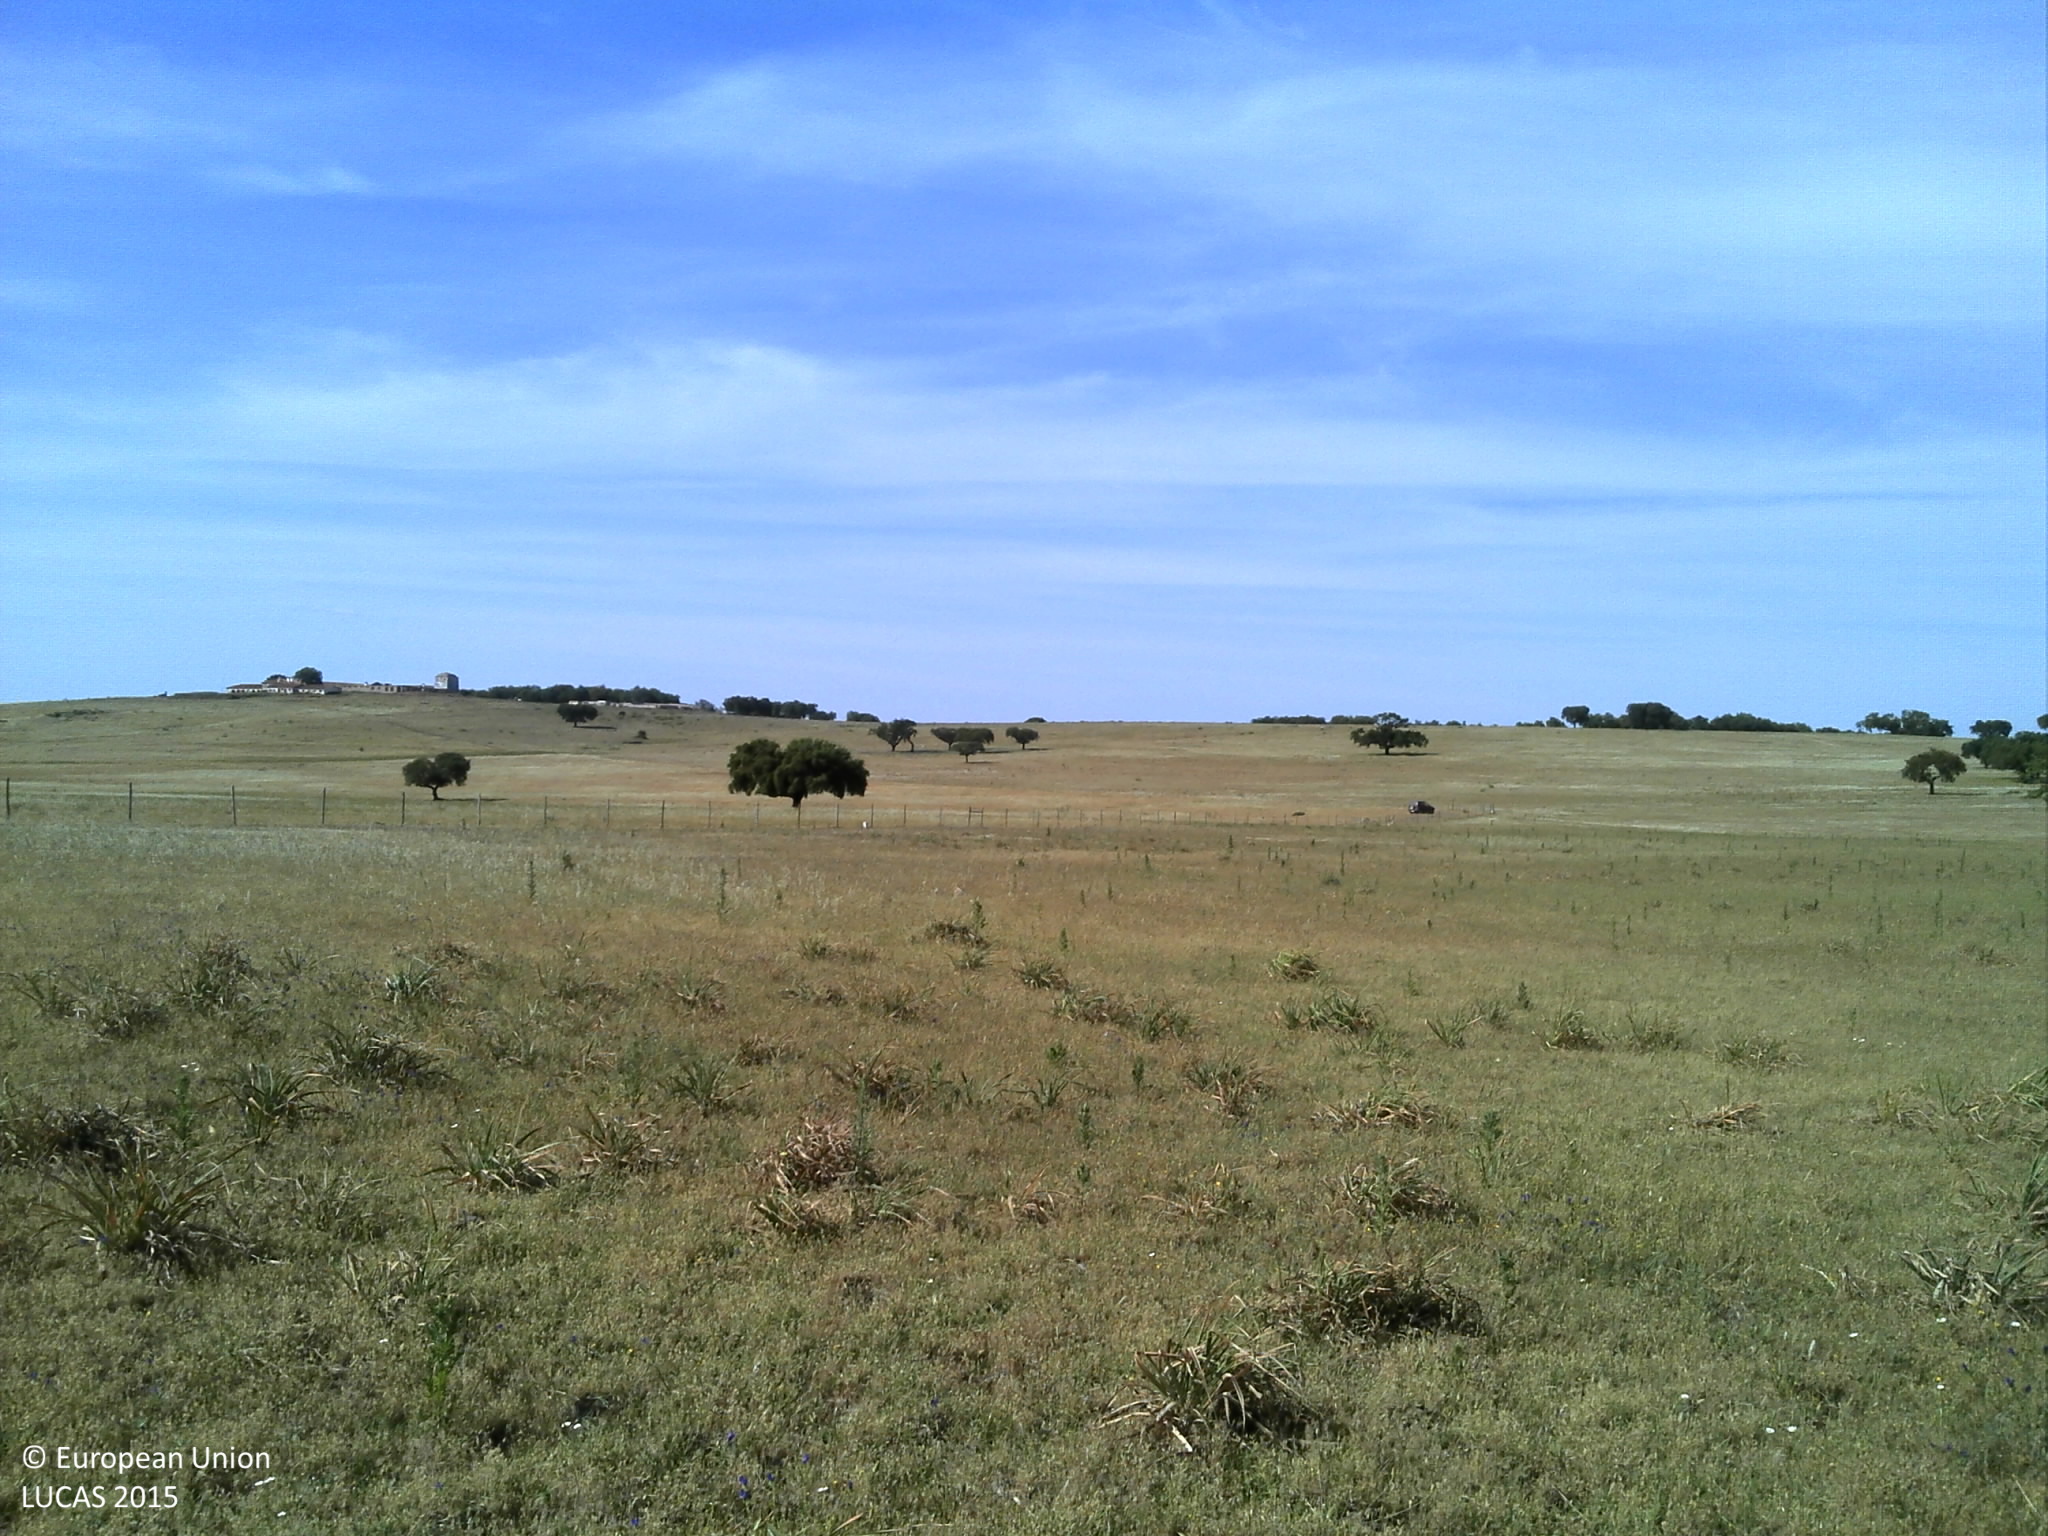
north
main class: Grassland
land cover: Grassland without tree/shrub cover
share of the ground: 50 - 75 %
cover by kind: herbaceous plants 85 %, unconsolidated bare surface 15 %
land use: Agriculture (excluding fallow land and kitchen gardens)
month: May
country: PT
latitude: 39.1826
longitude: -7.5814
